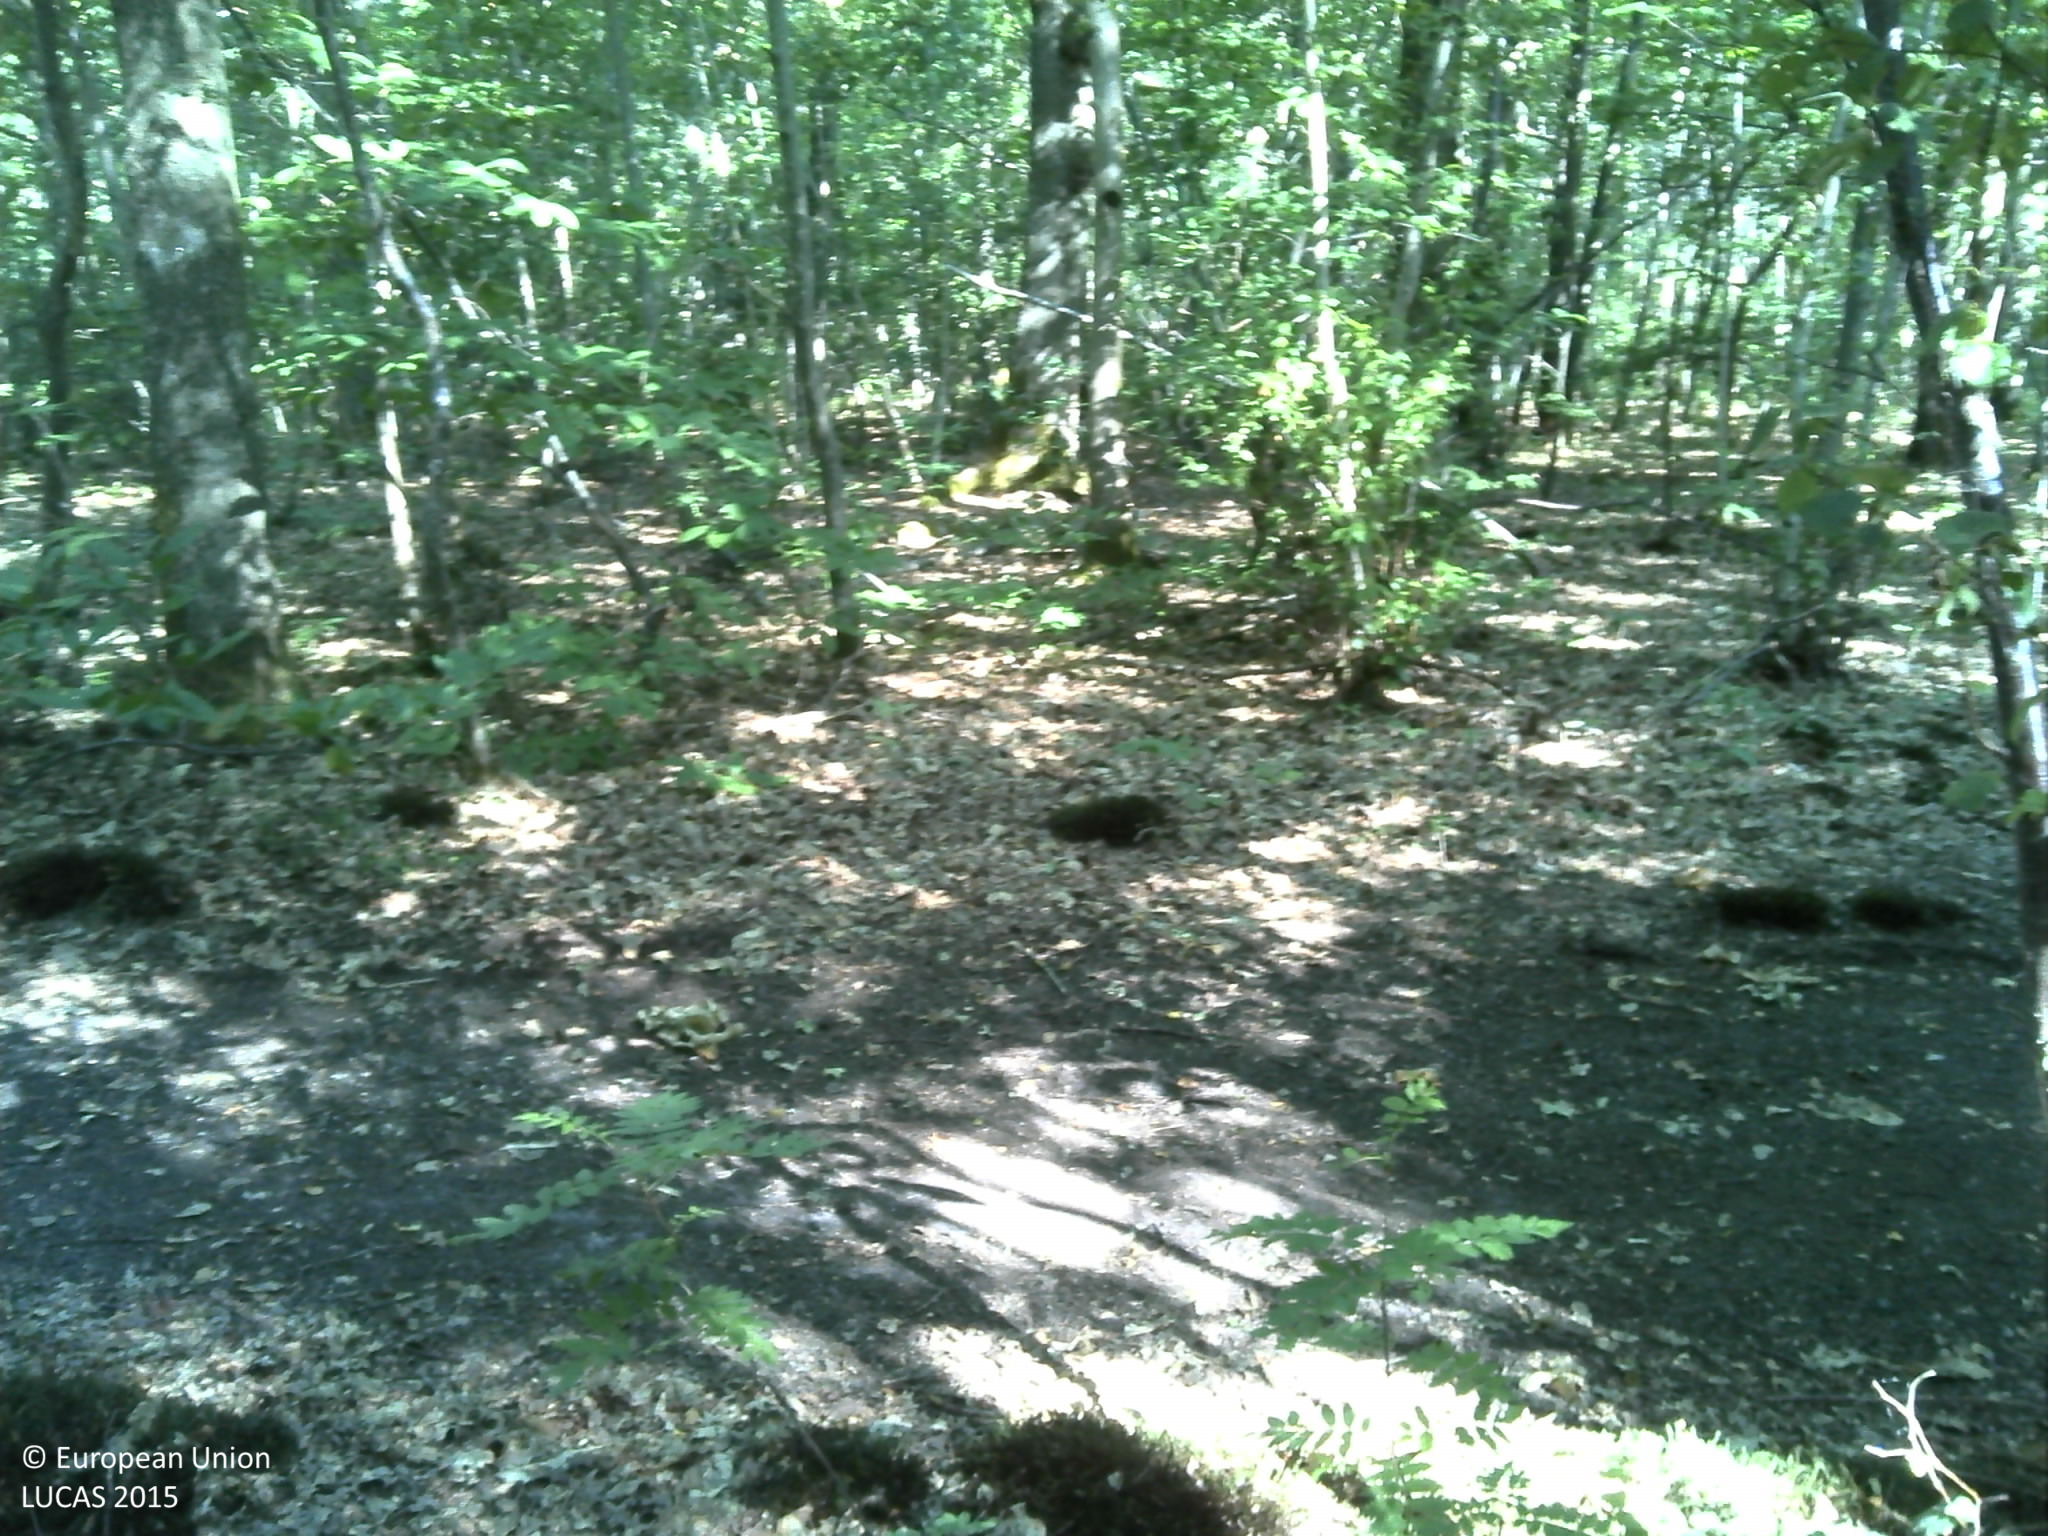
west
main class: Woodland
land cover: Broadleaved woodland
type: thermophilous deciduous forest
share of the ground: > 75 %
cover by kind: broadleaved forest trees 90 %, shrubs 10 %
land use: Forestry
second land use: Amenities, museums, leisure
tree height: > 5 m
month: August
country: FR
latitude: 48.7027
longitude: 1.9006
